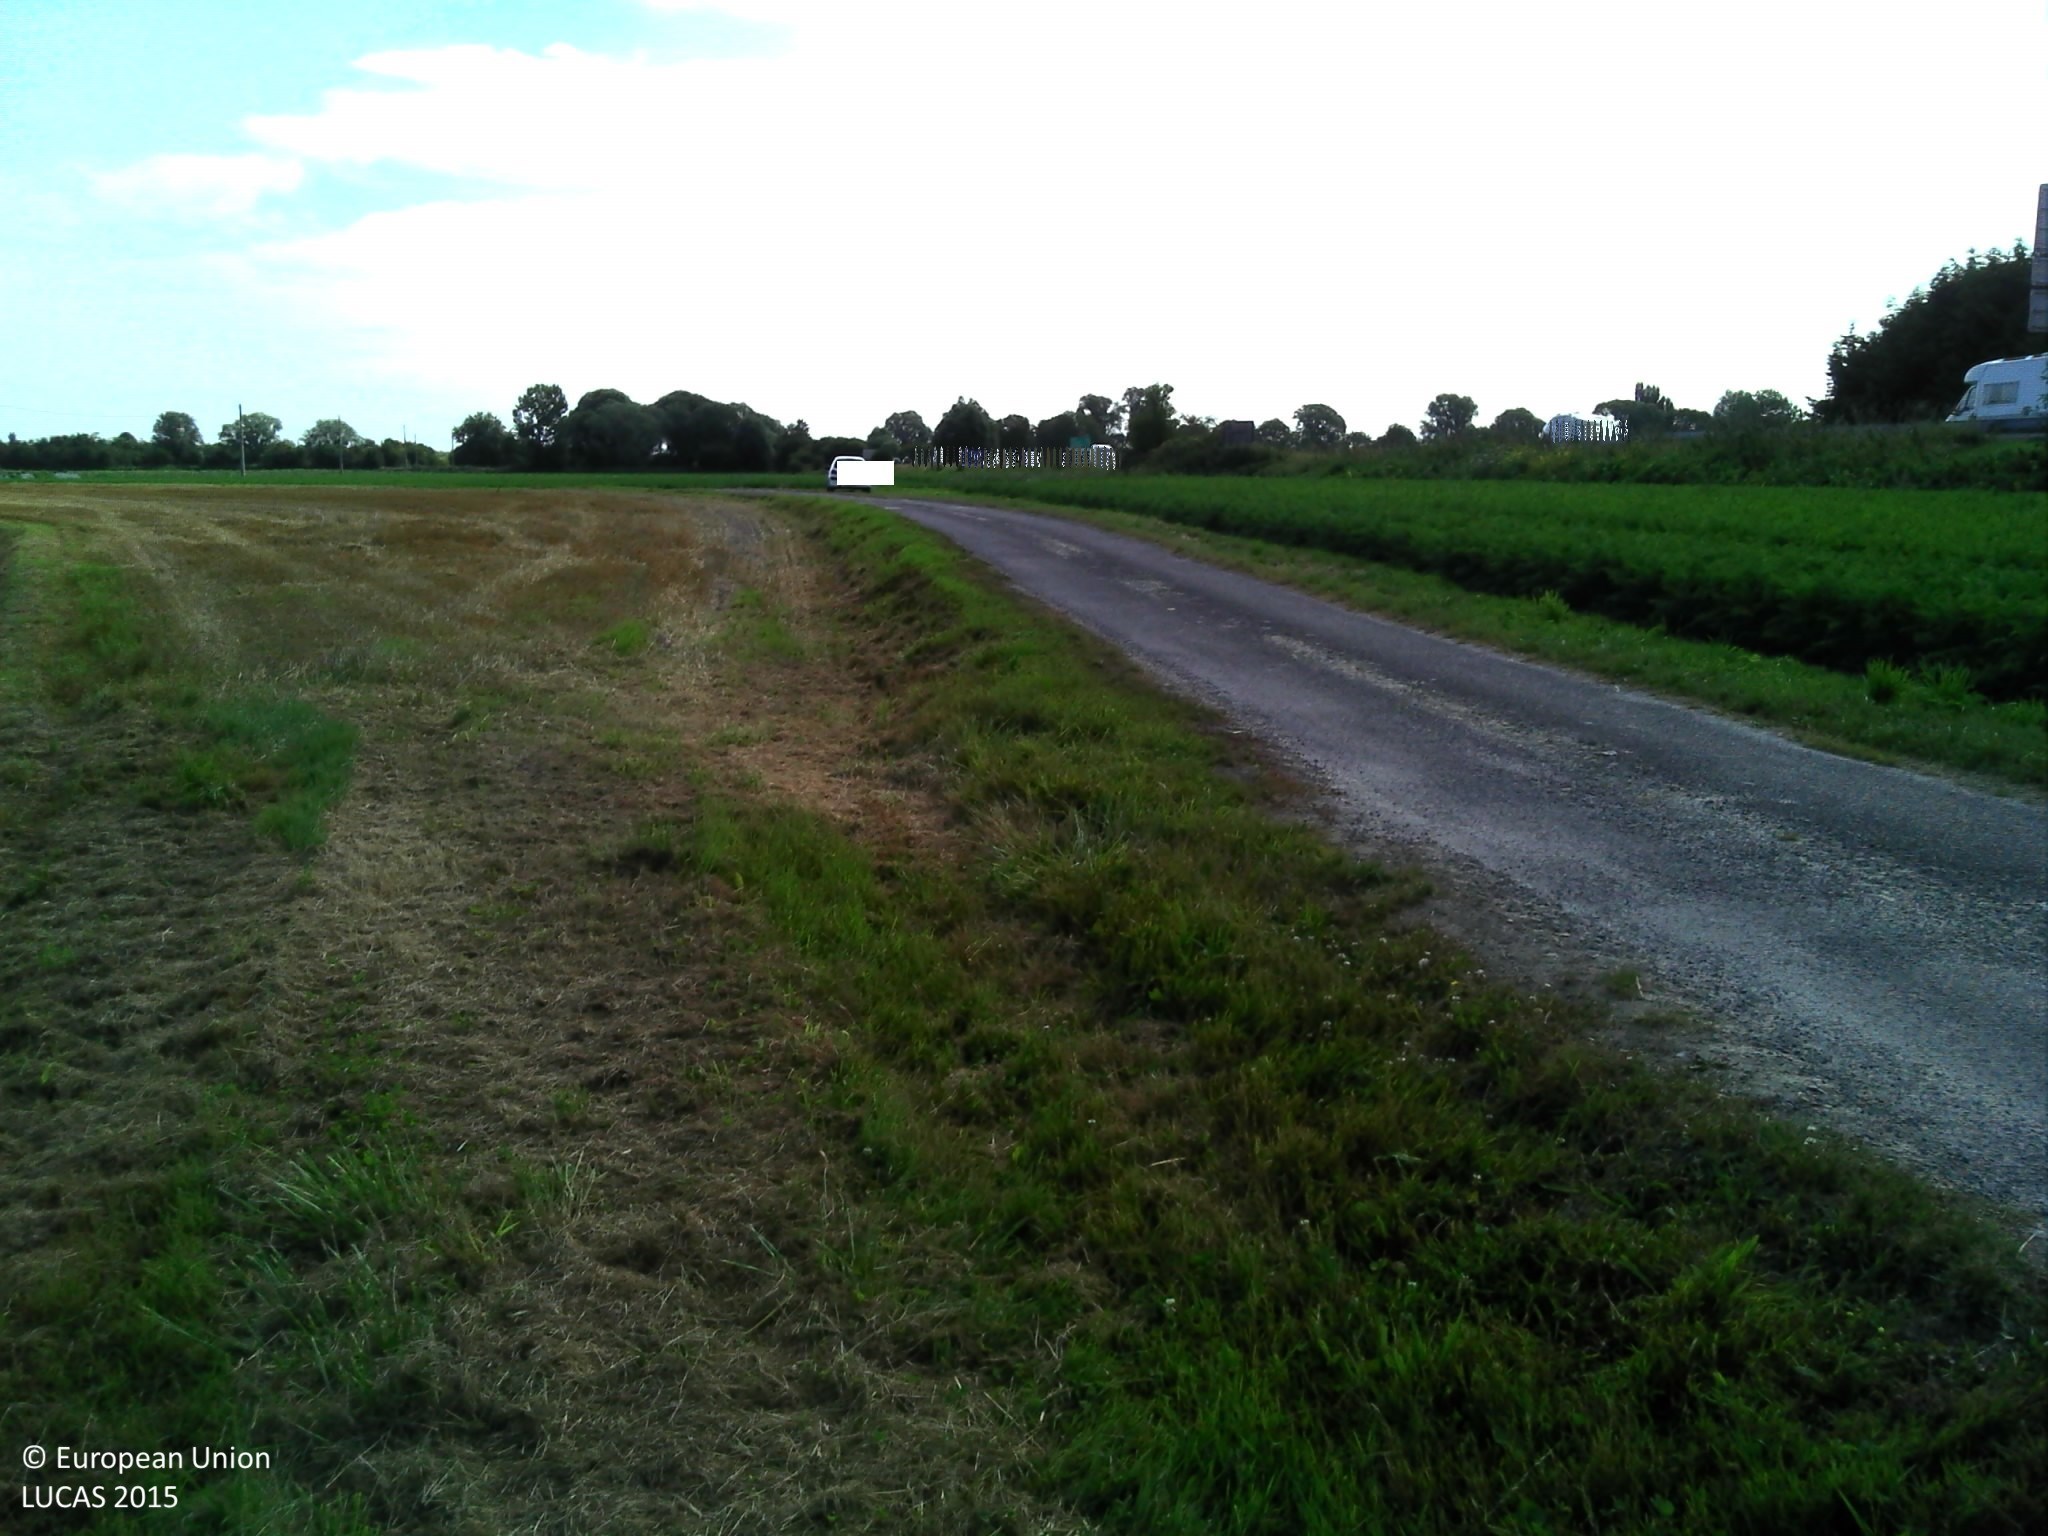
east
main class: Grassland
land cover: Grassland without tree/shrub cover
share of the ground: > 75 %
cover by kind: herbaceous plants 100 %
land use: Road transport
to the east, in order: Grassland without tree/shrub cover; Common wheat; Grass margins; Paved roads, cycling and walking lanes; Grass margins; Other fresh vegetables; Grassland without tree/shrub cover; Other fresh vegetables; Spontaneously vegetated surfaces
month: August
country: FR
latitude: 48.5619
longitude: -1.5246
